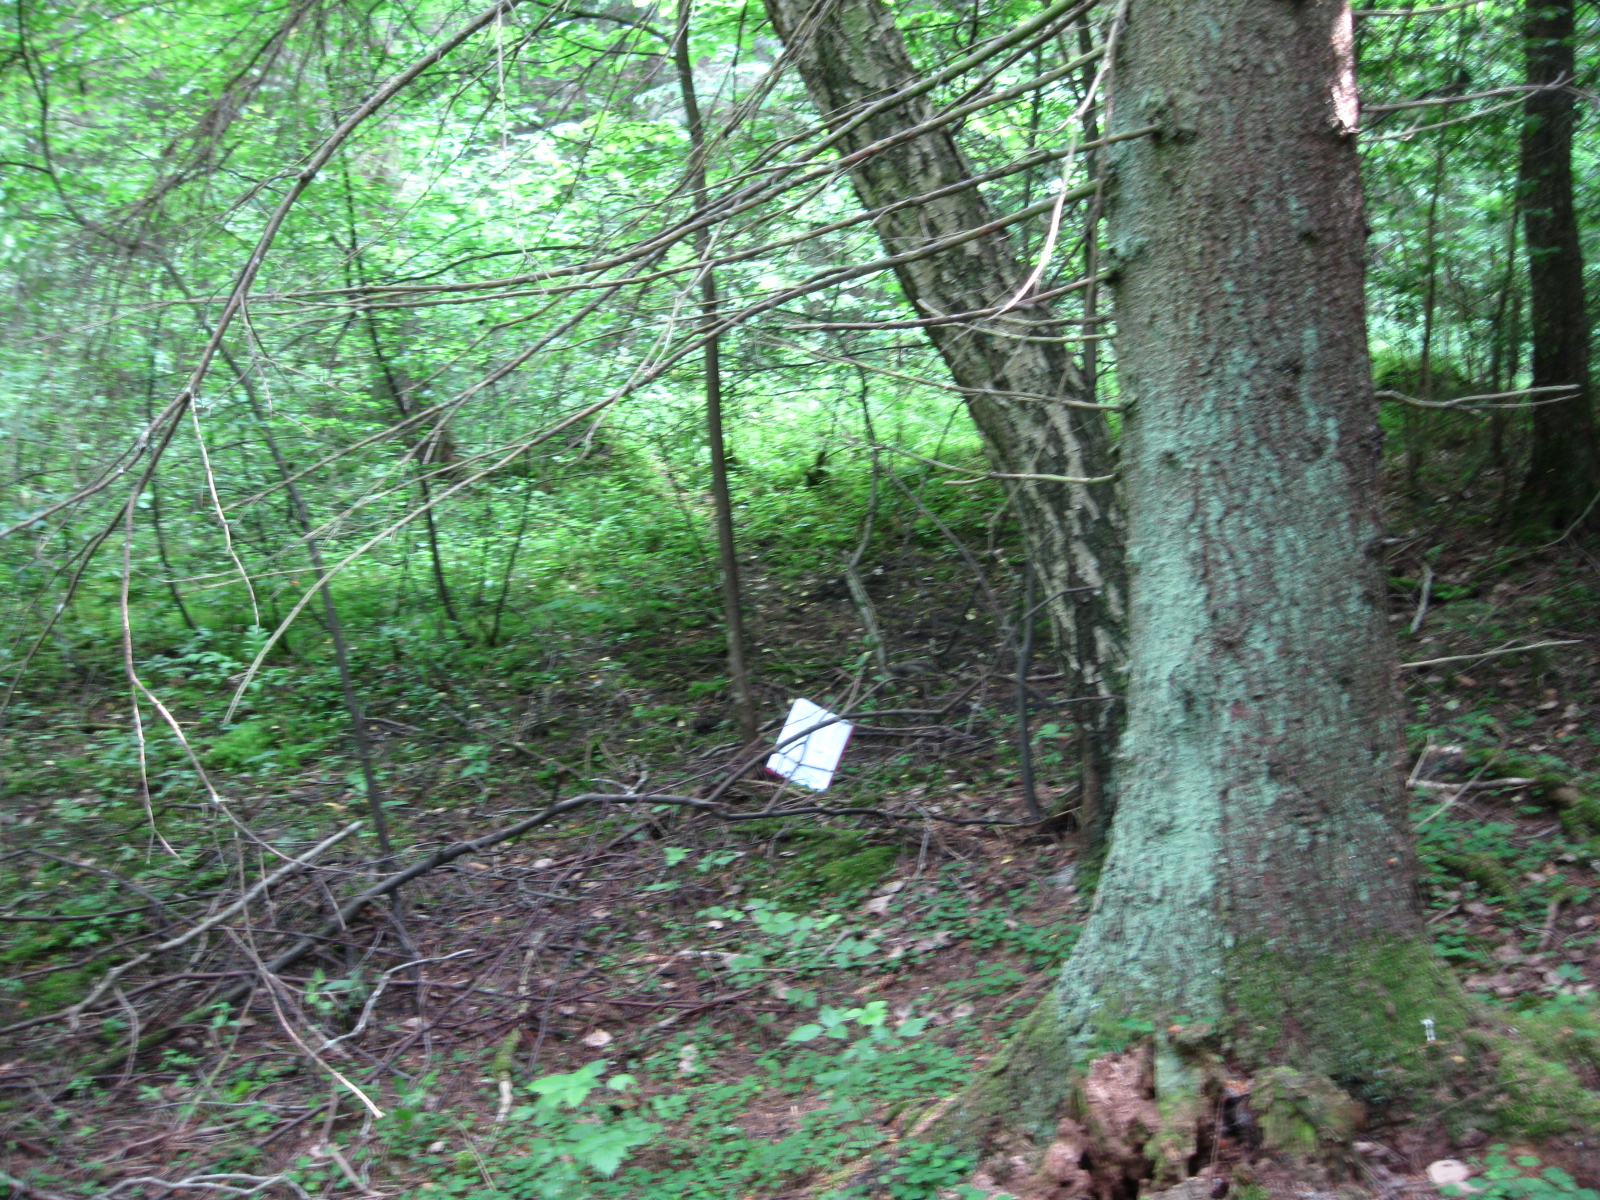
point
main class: Woodland
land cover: Spruce dominated mixed woodland
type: hemiboreal forest and nemoral coniferous forest and mixed broadleaved-coniferous forest
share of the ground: > 75 %
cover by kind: coniferous forest trees 45 %, broadleaved forest trees 40 %, shrubs 5 %, herbaceous plants 5 %, lichens and mosses 5 %
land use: Forestry
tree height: > 5 m
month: June
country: LT
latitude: 55.5968
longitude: 23.8446
